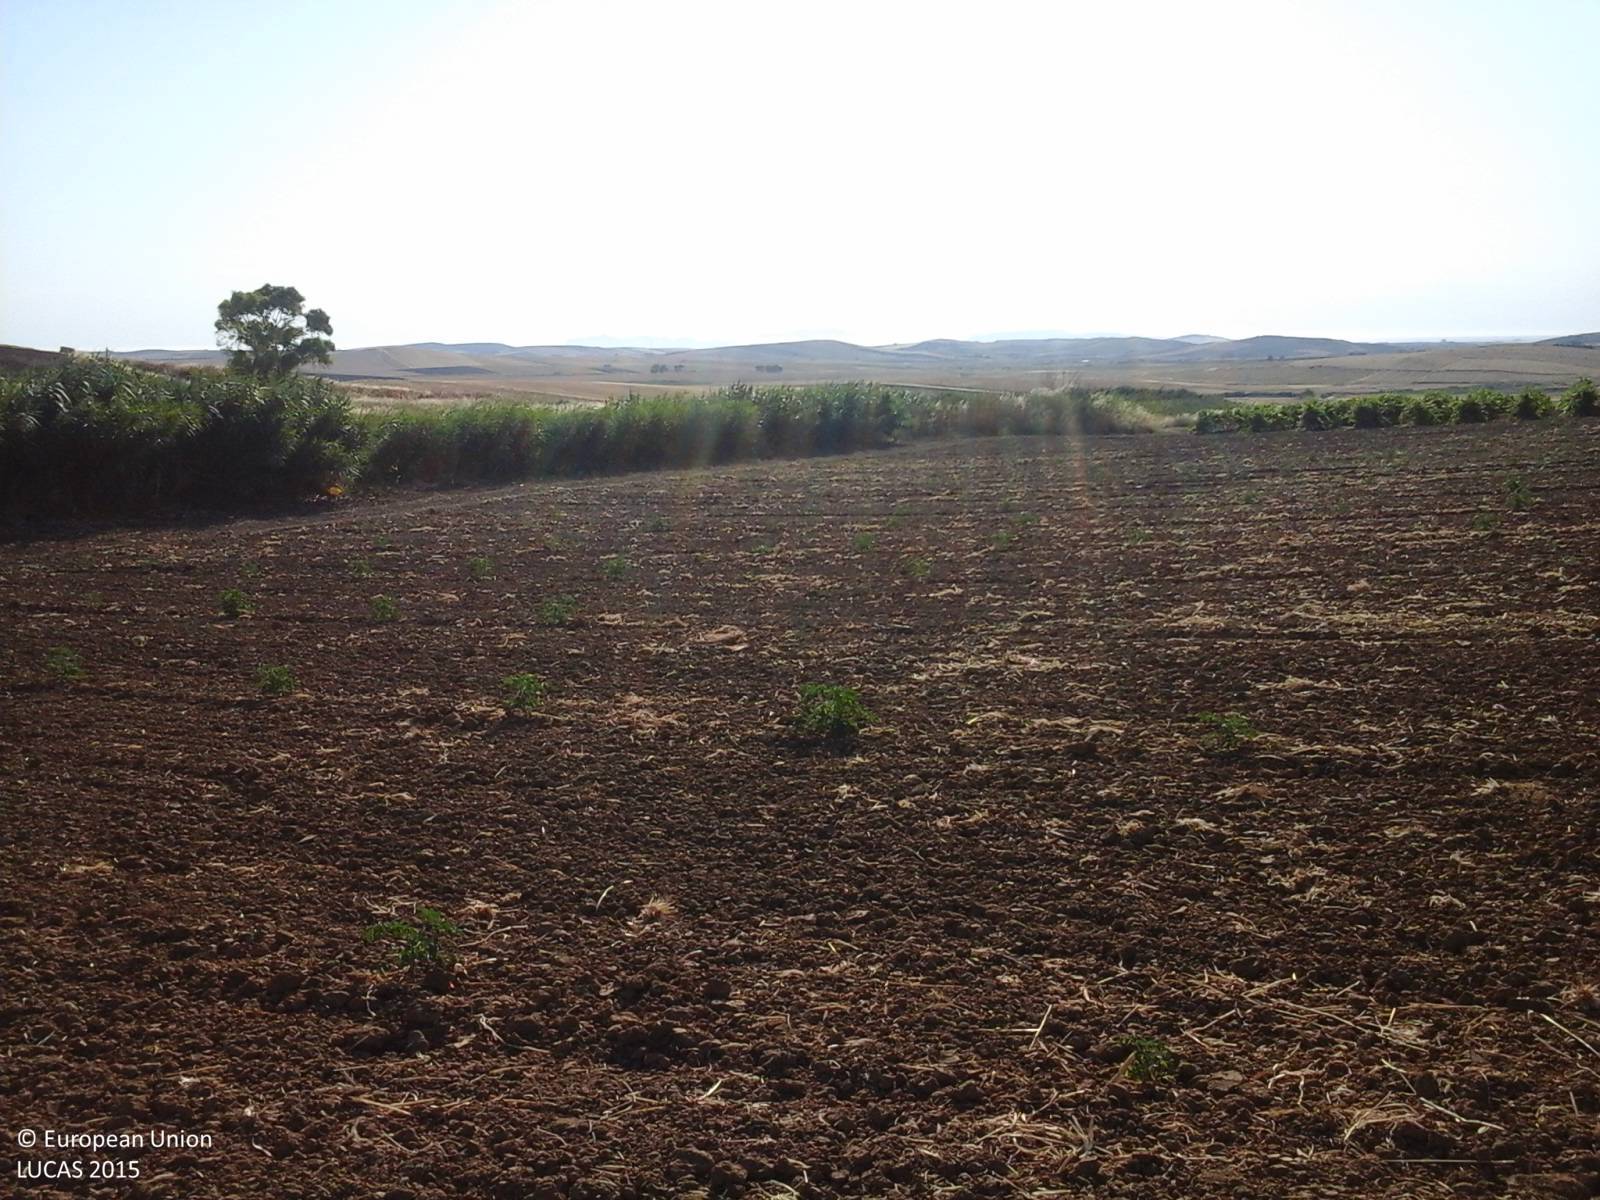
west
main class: Cropland
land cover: Tomatoes
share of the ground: < 10 %
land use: Agriculture (excluding fallow land and kitchen gardens)
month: June
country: IT
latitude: 37.9466
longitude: 12.6548
